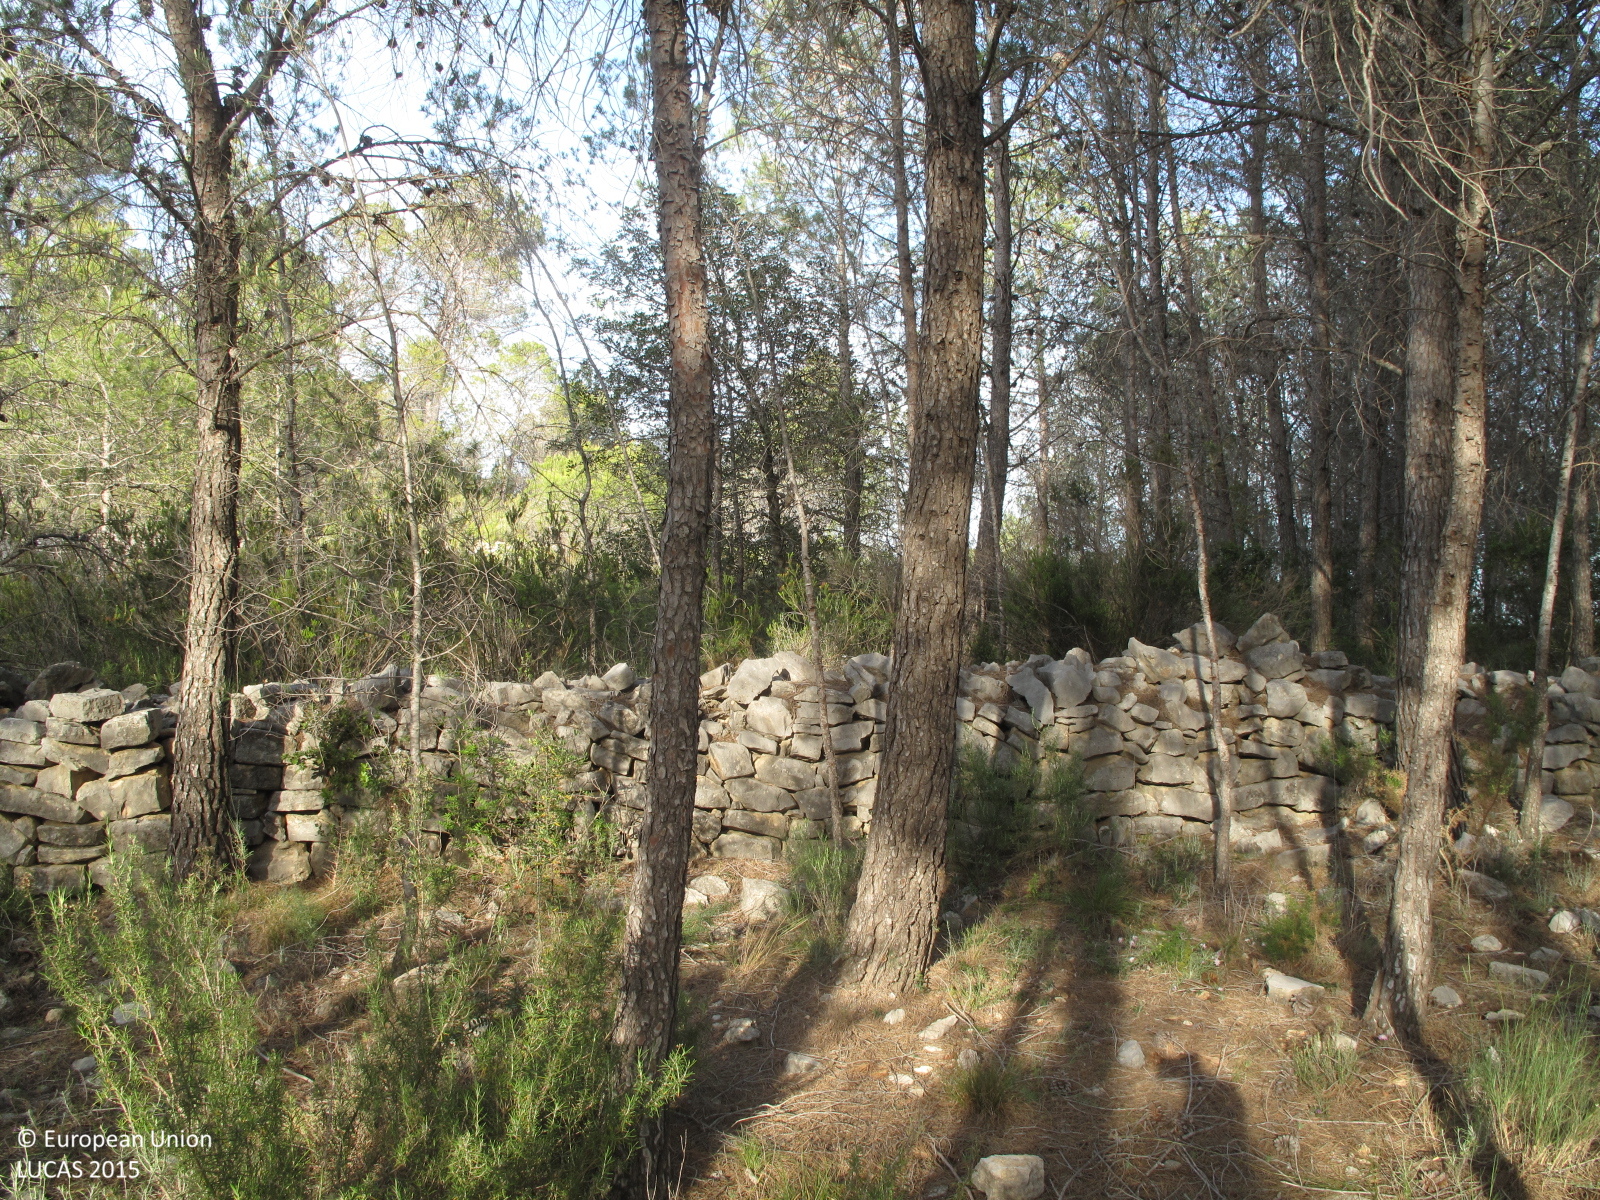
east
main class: Woodland
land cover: Pine dominated coniferous woodland
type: coniferous forest of the mediterranean region
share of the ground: 50 - 75 %
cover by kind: coniferous forest trees 60 %, shrubs 20 %, herbaceous plants 15 %, consolidated bare surface 5 %
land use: Semi-natural and natural areas not in use
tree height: > 5 m
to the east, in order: Pine dominated coniferous woodland; Dry stone walls; Pine dominated coniferous woodland; Permanent industrial crops; Fences; Artificial constructions in urban areas
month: May
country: ES
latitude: 39.0542
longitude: -0.7527
